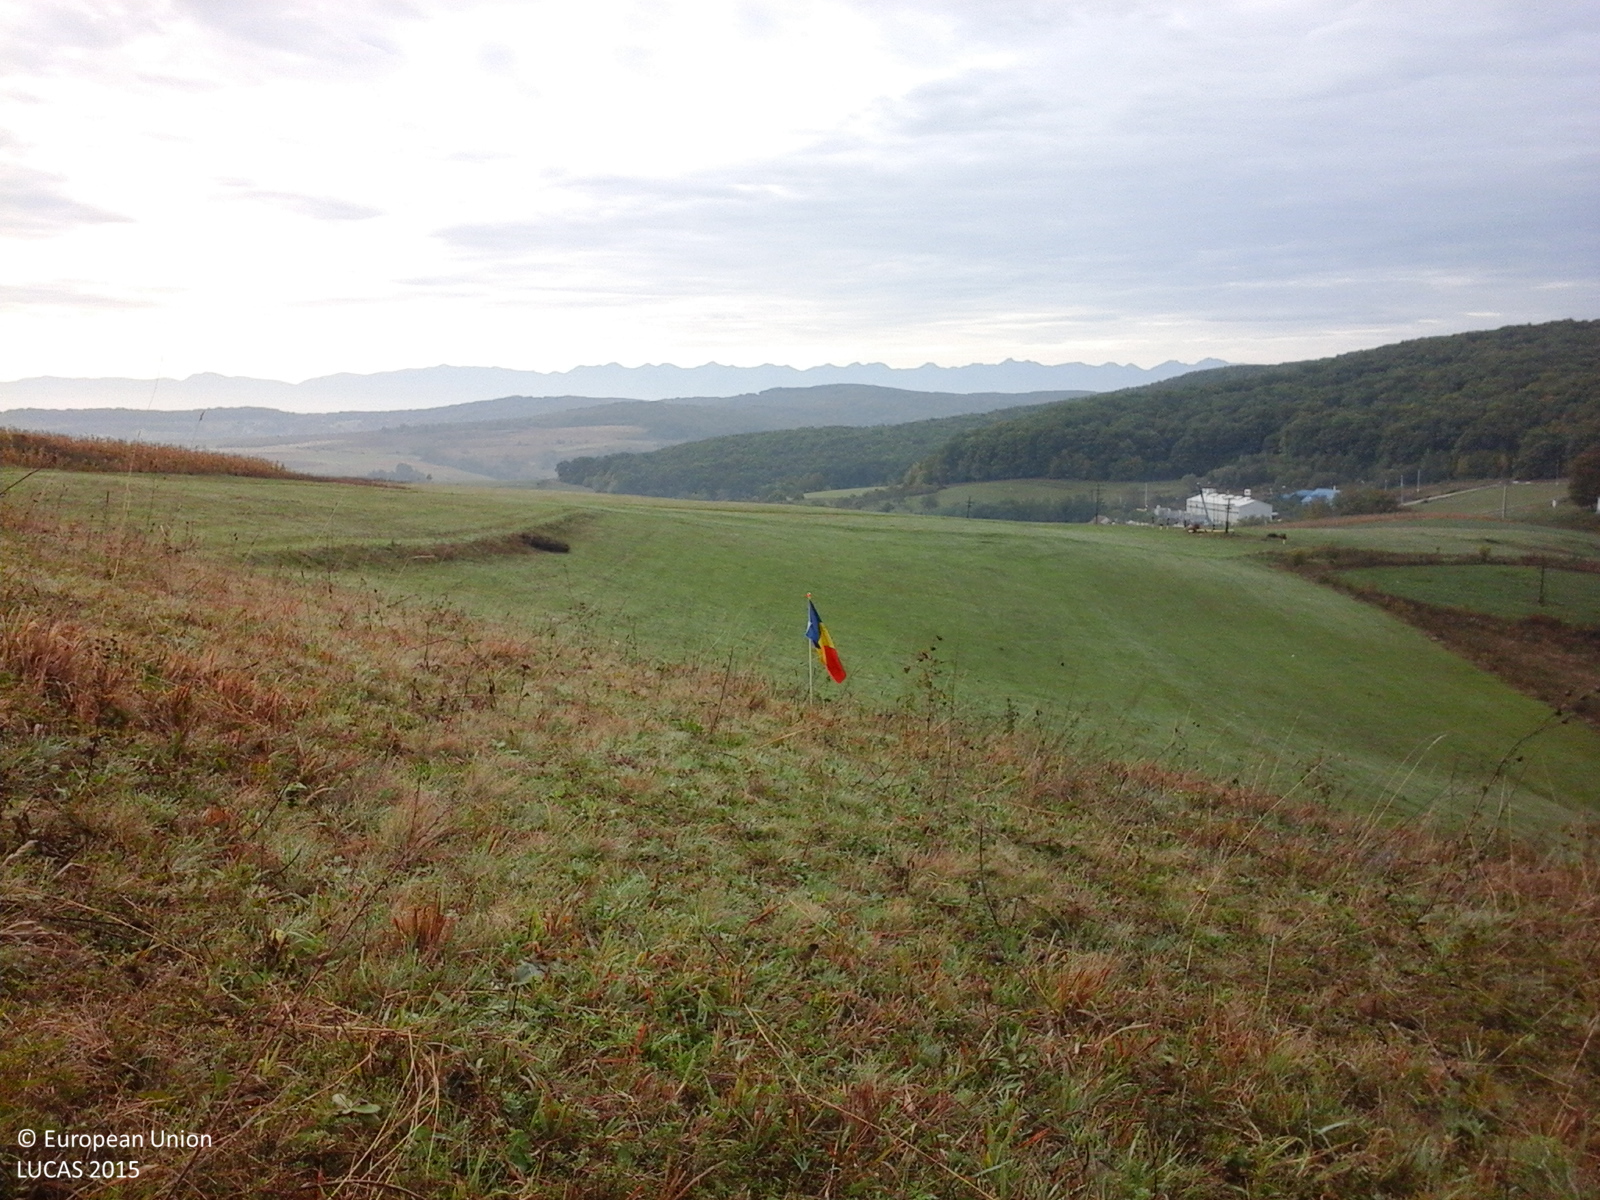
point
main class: Grassland
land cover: Grassland without tree/shrub cover
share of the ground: > 75 %
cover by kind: herbaceous plants 100 %
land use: Agriculture (excluding fallow land and kitchen gardens)
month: October
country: RO
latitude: 45.9890
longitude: 24.6881
